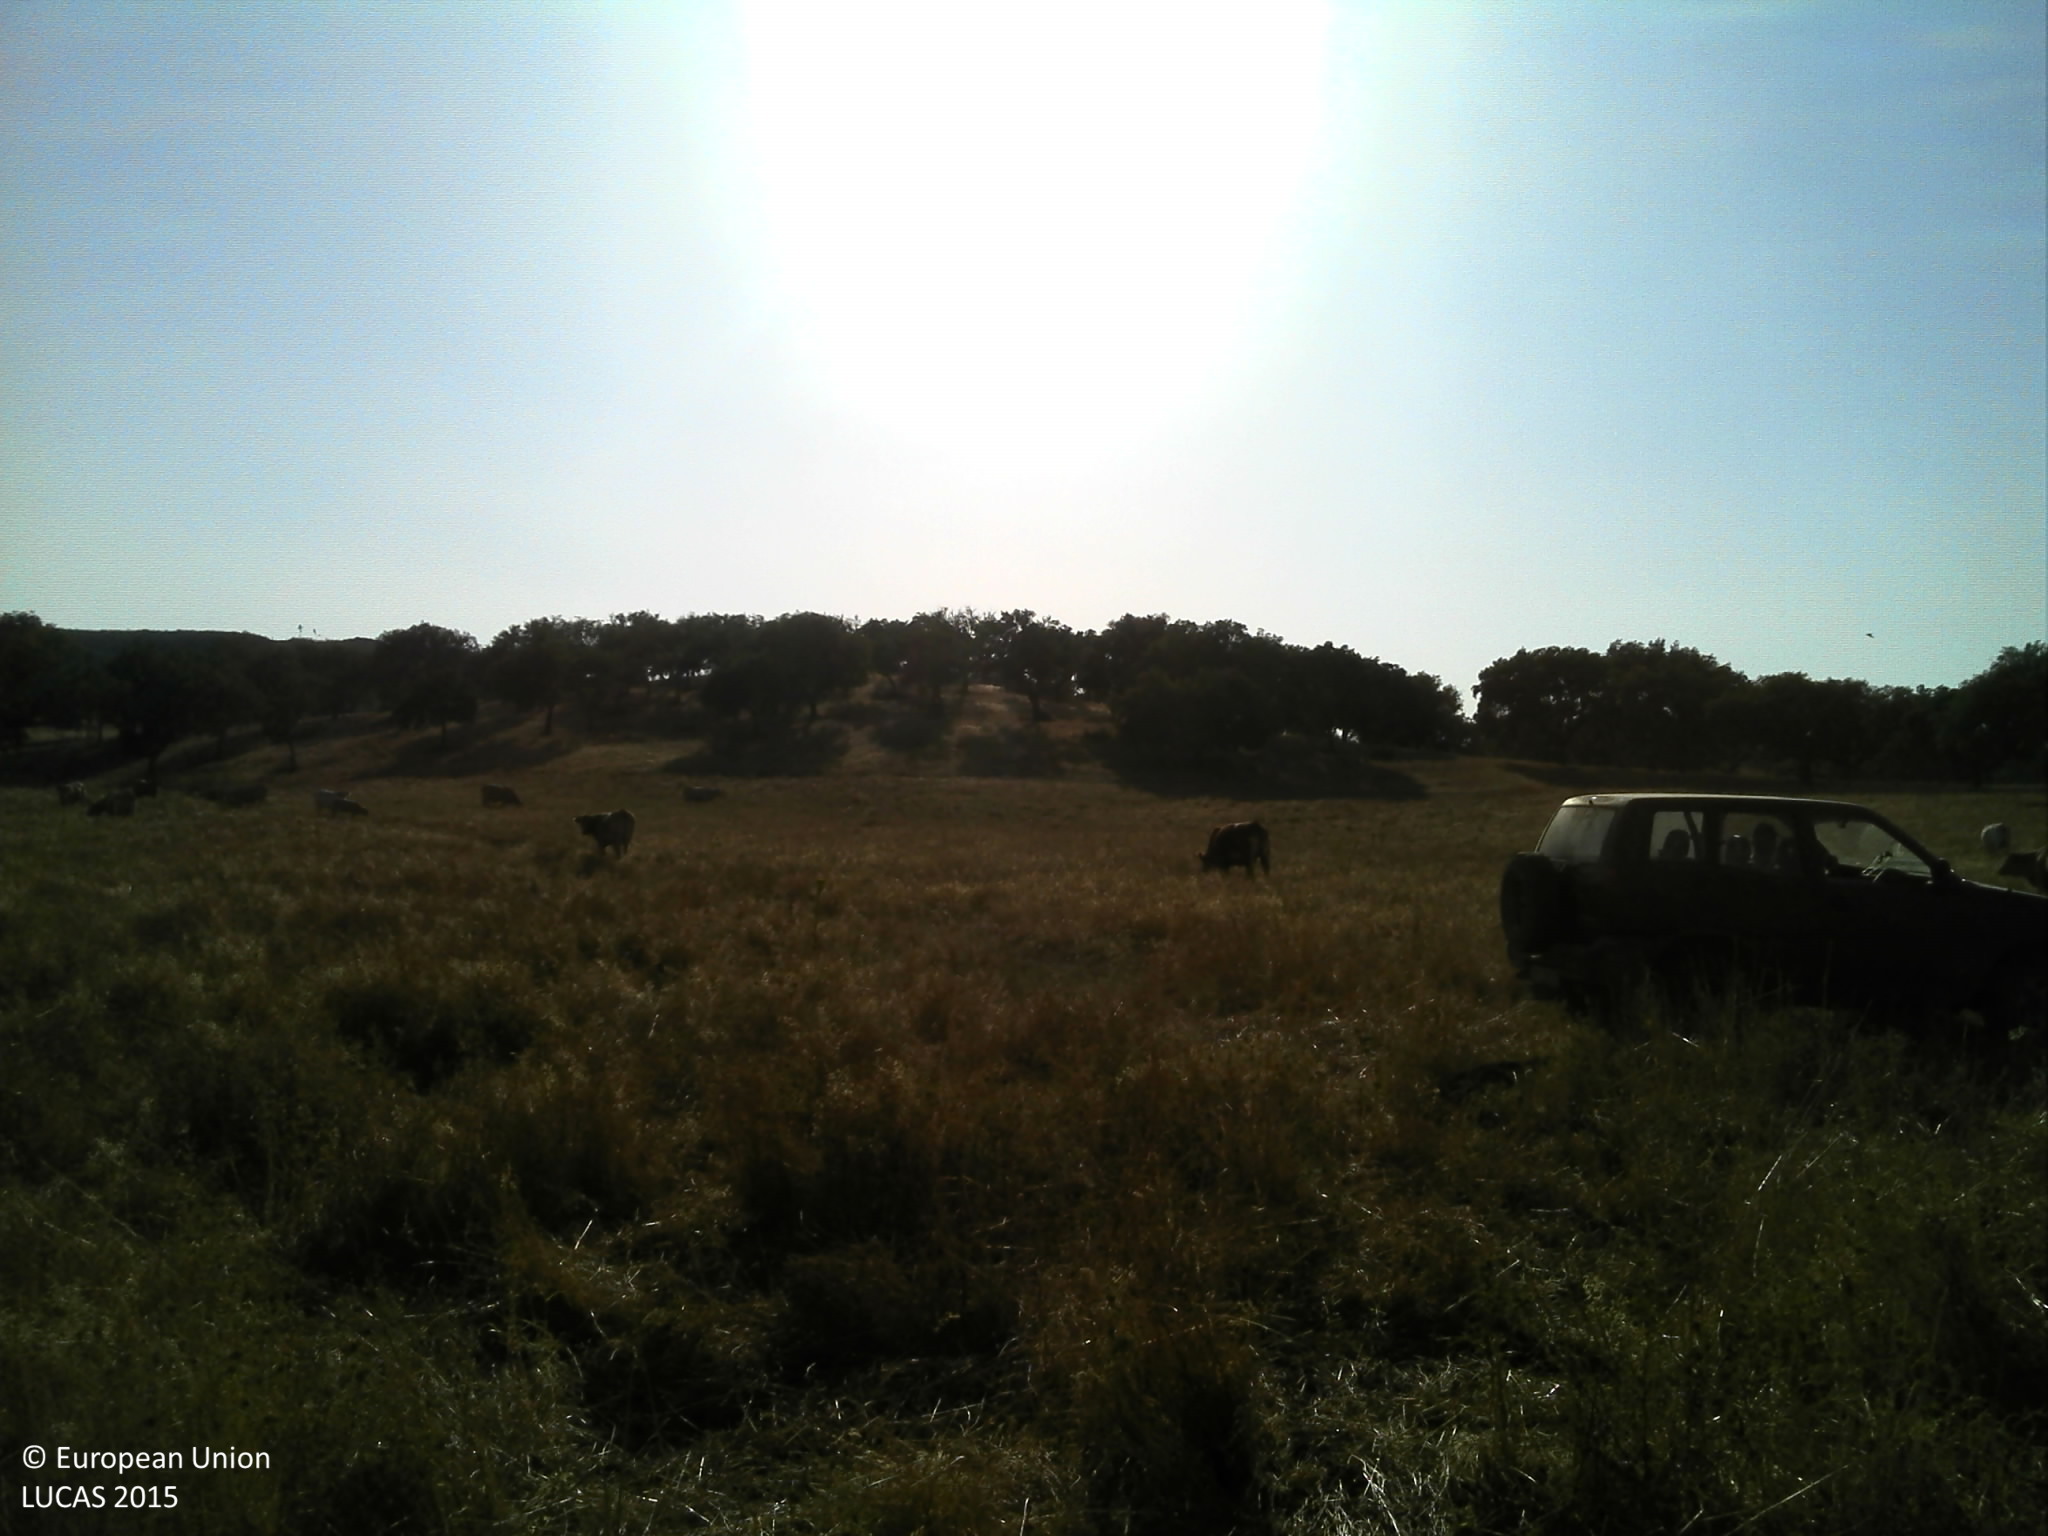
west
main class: Grassland
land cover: Grassland without tree/shrub cover
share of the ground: 50 - 75 %
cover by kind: herbaceous plants 75 %, unconsolidated bare surface 25 %
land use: Agriculture (excluding fallow land and kitchen gardens)
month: July
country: PT
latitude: 38.7657
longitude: -7.5393
